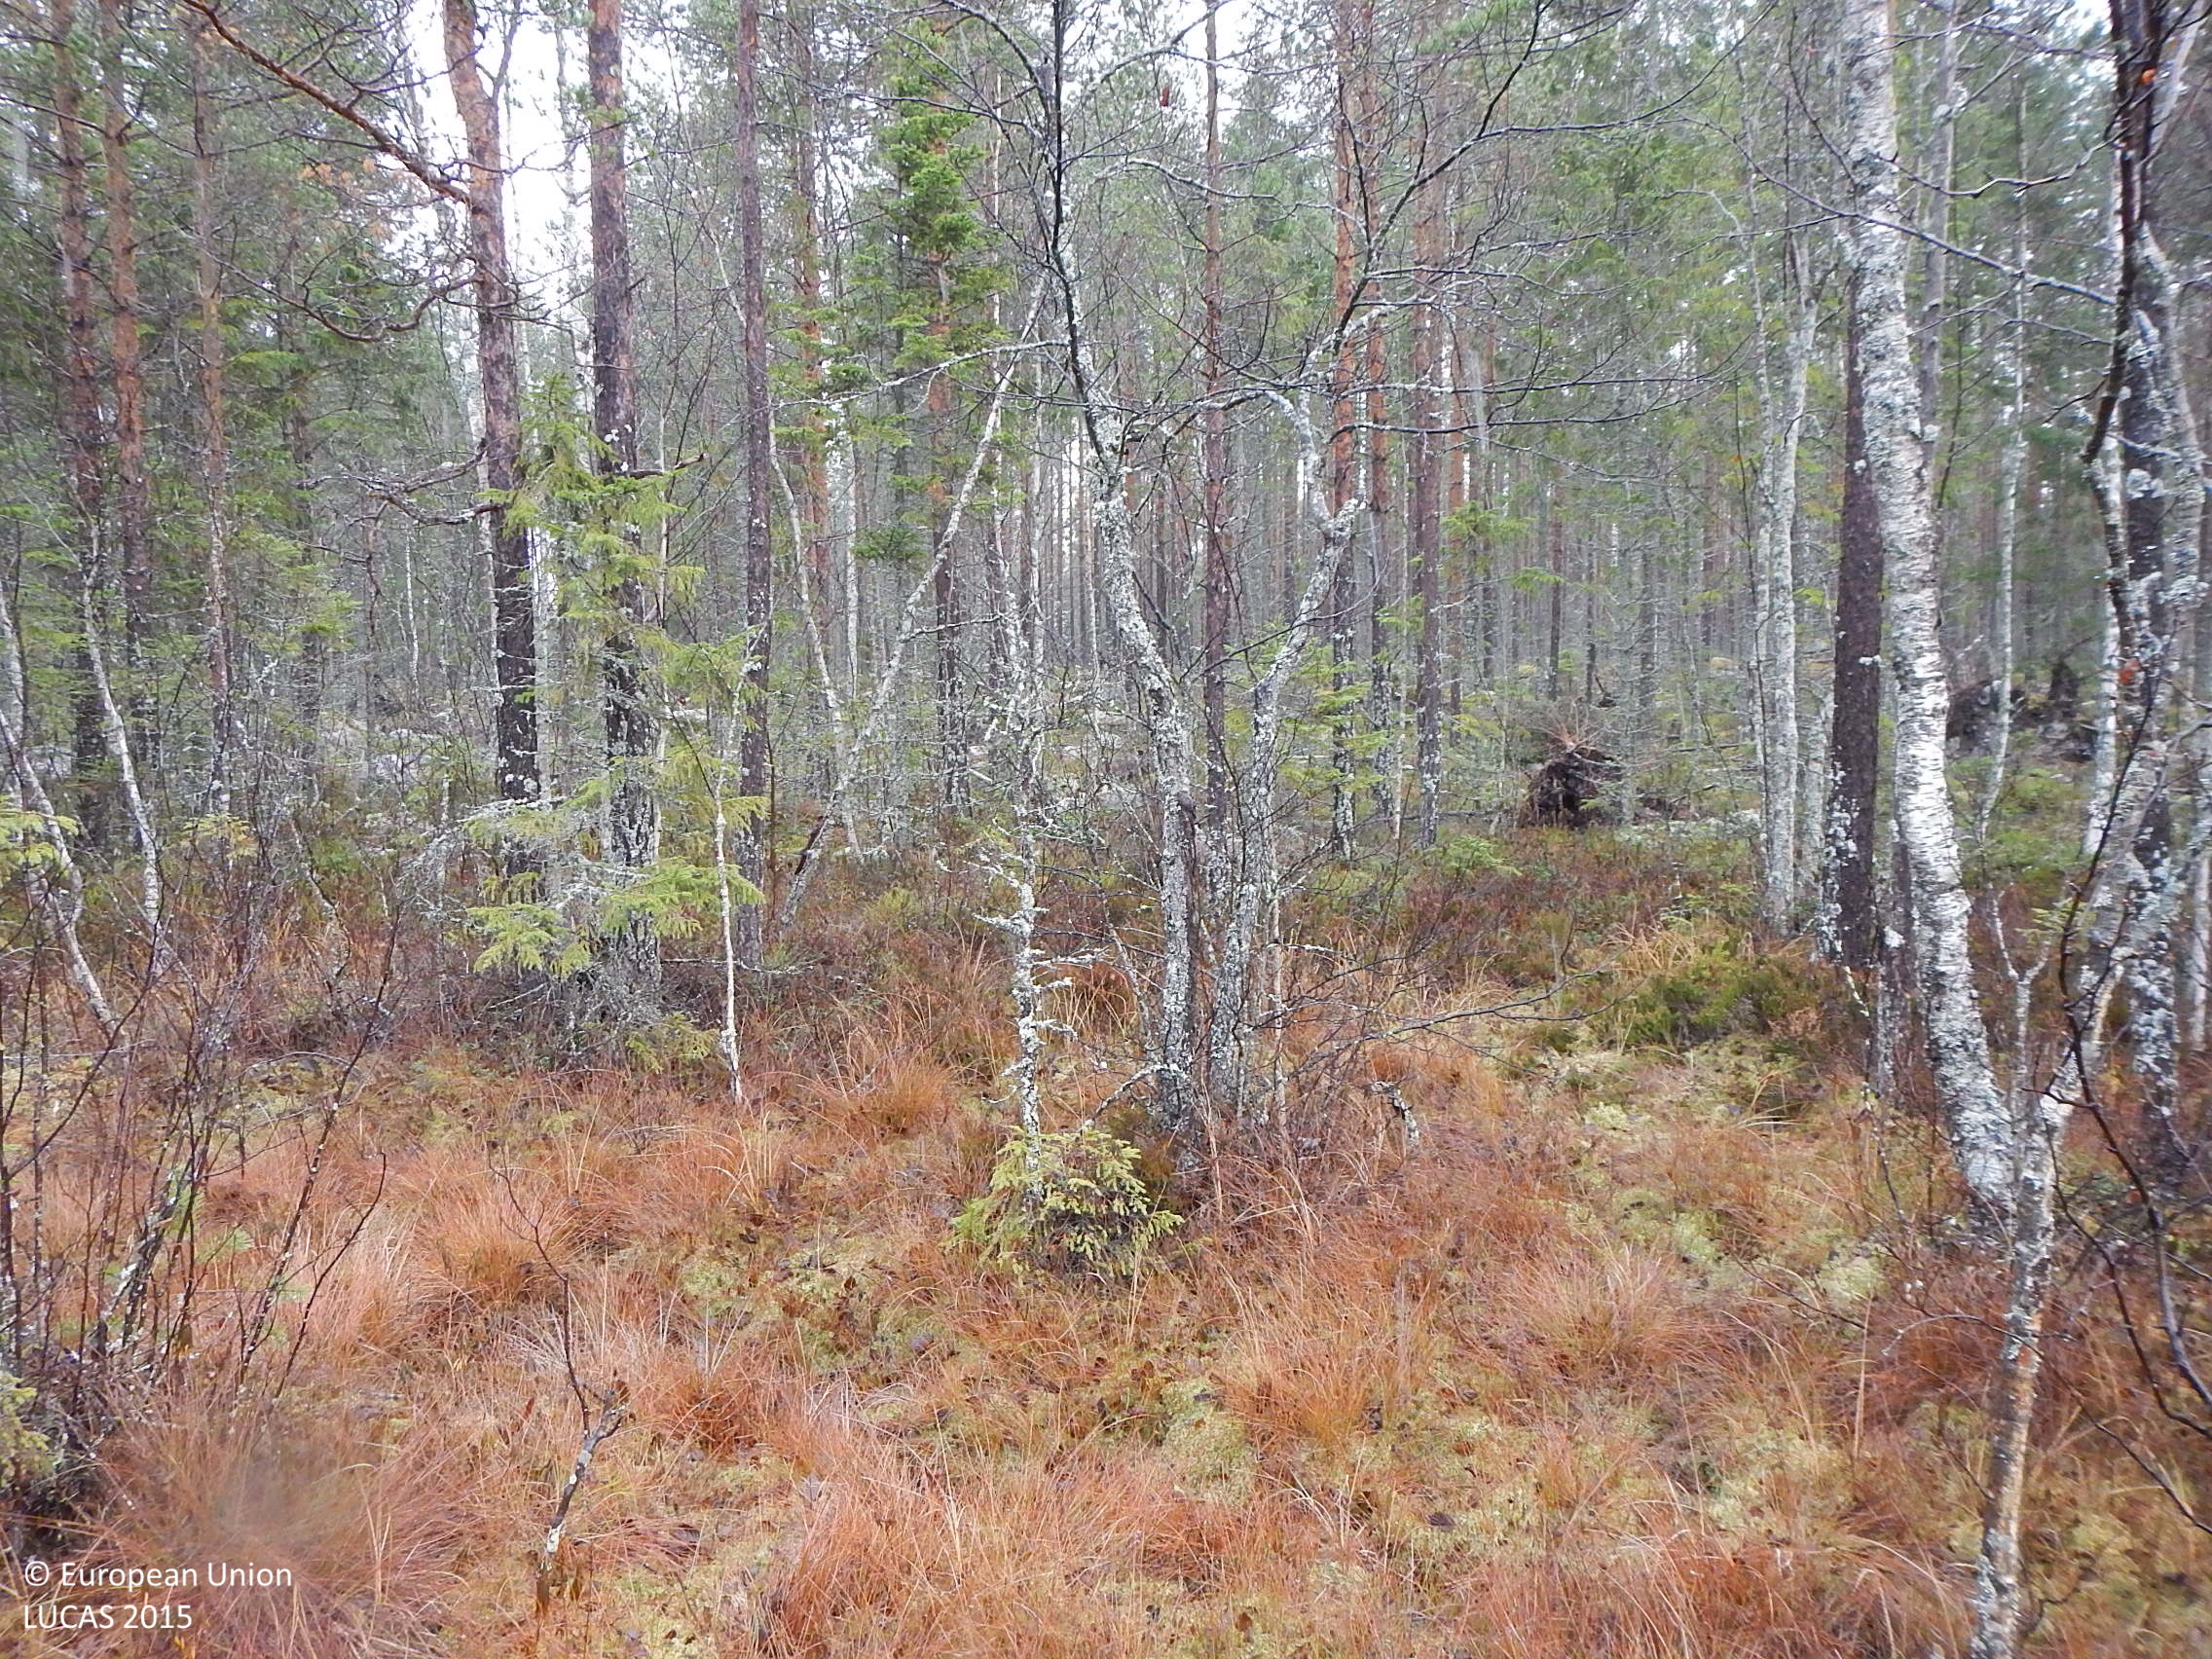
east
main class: Woodland
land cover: Pine dominated mixed woodland
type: mire and swamp forests
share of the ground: 50 - 75 %
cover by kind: coniferous forest trees 30 %, herbaceous plants 30 %, broadleaved forest trees 20 %, lichens and mosses 20 %
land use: Forestry
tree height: > 5 m
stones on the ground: < 10 %
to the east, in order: Pine dominated mixed woodland; Other coniferous woodland; Tracks; Other coniferous woodland; Tracks; Spruce dominated mixed woodland
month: November
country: SE
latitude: 61.4350
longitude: 17.0155
